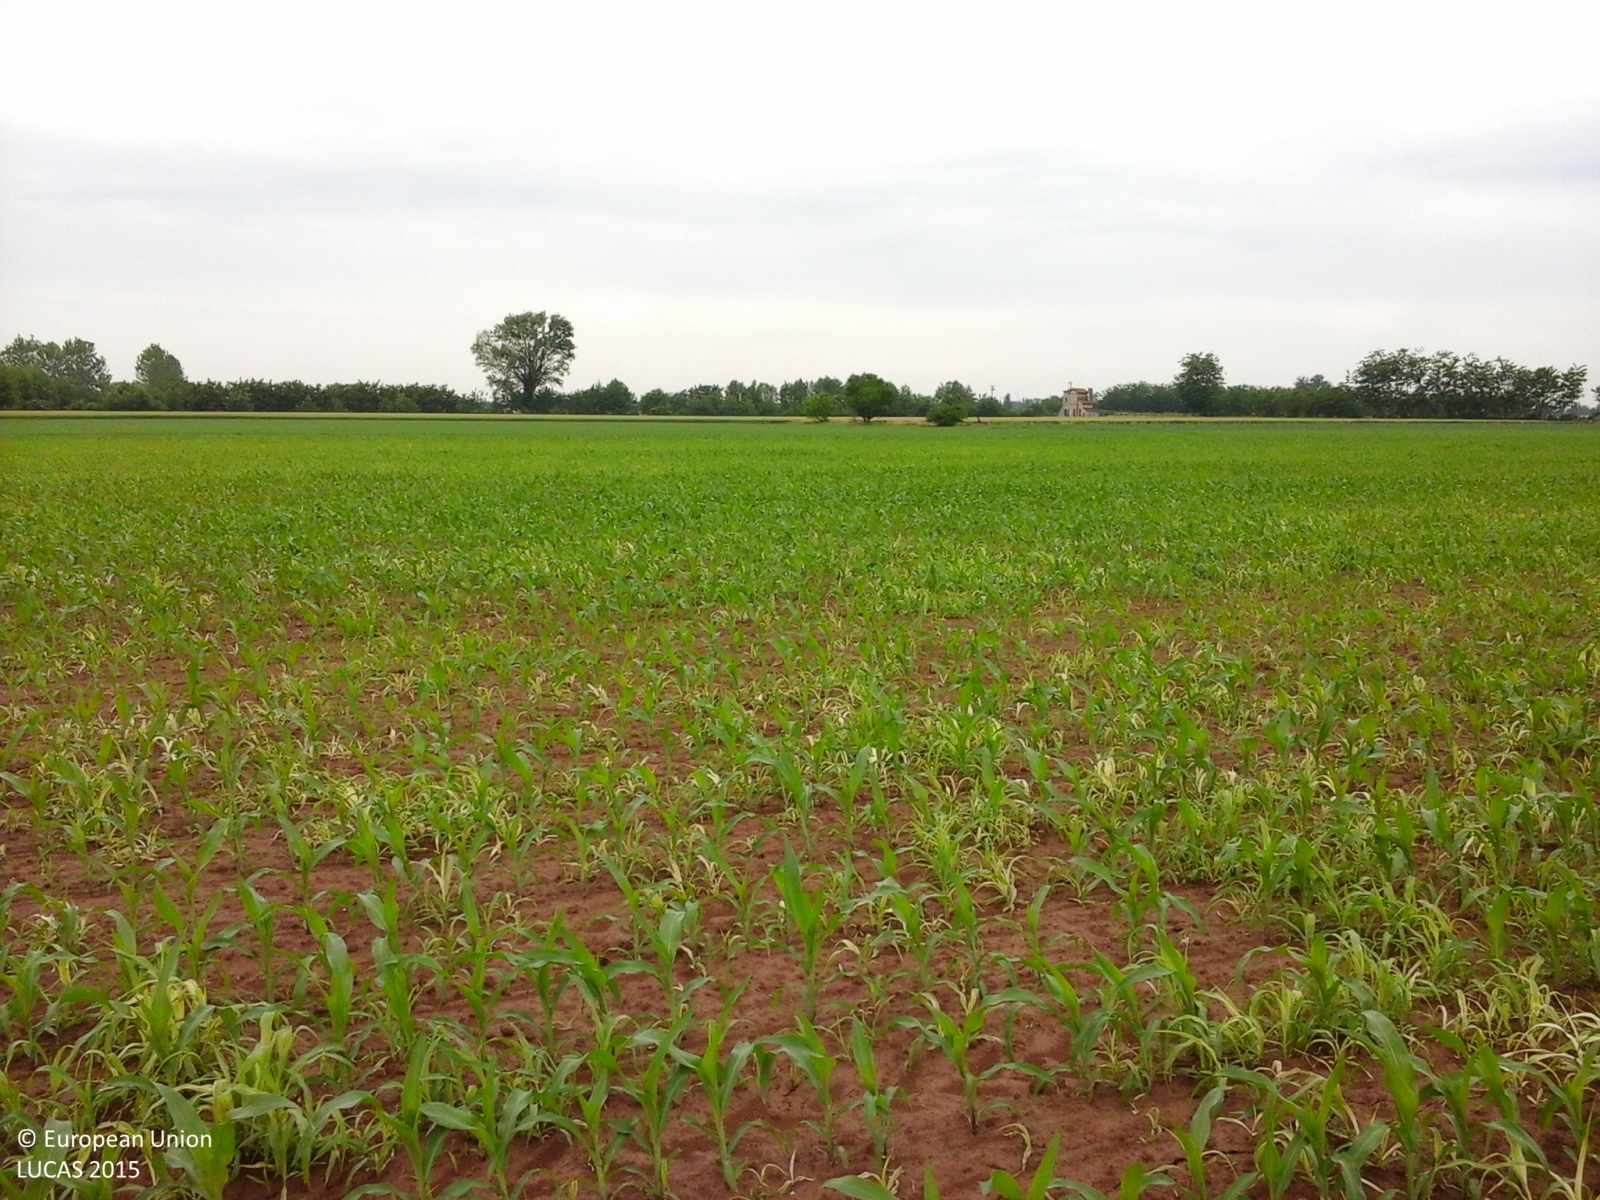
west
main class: Cropland
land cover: Maize
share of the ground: 50 - 75 %
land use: Agriculture (excluding fallow land and kitchen gardens)
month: May
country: IT
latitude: 45.2159
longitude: 10.1906
